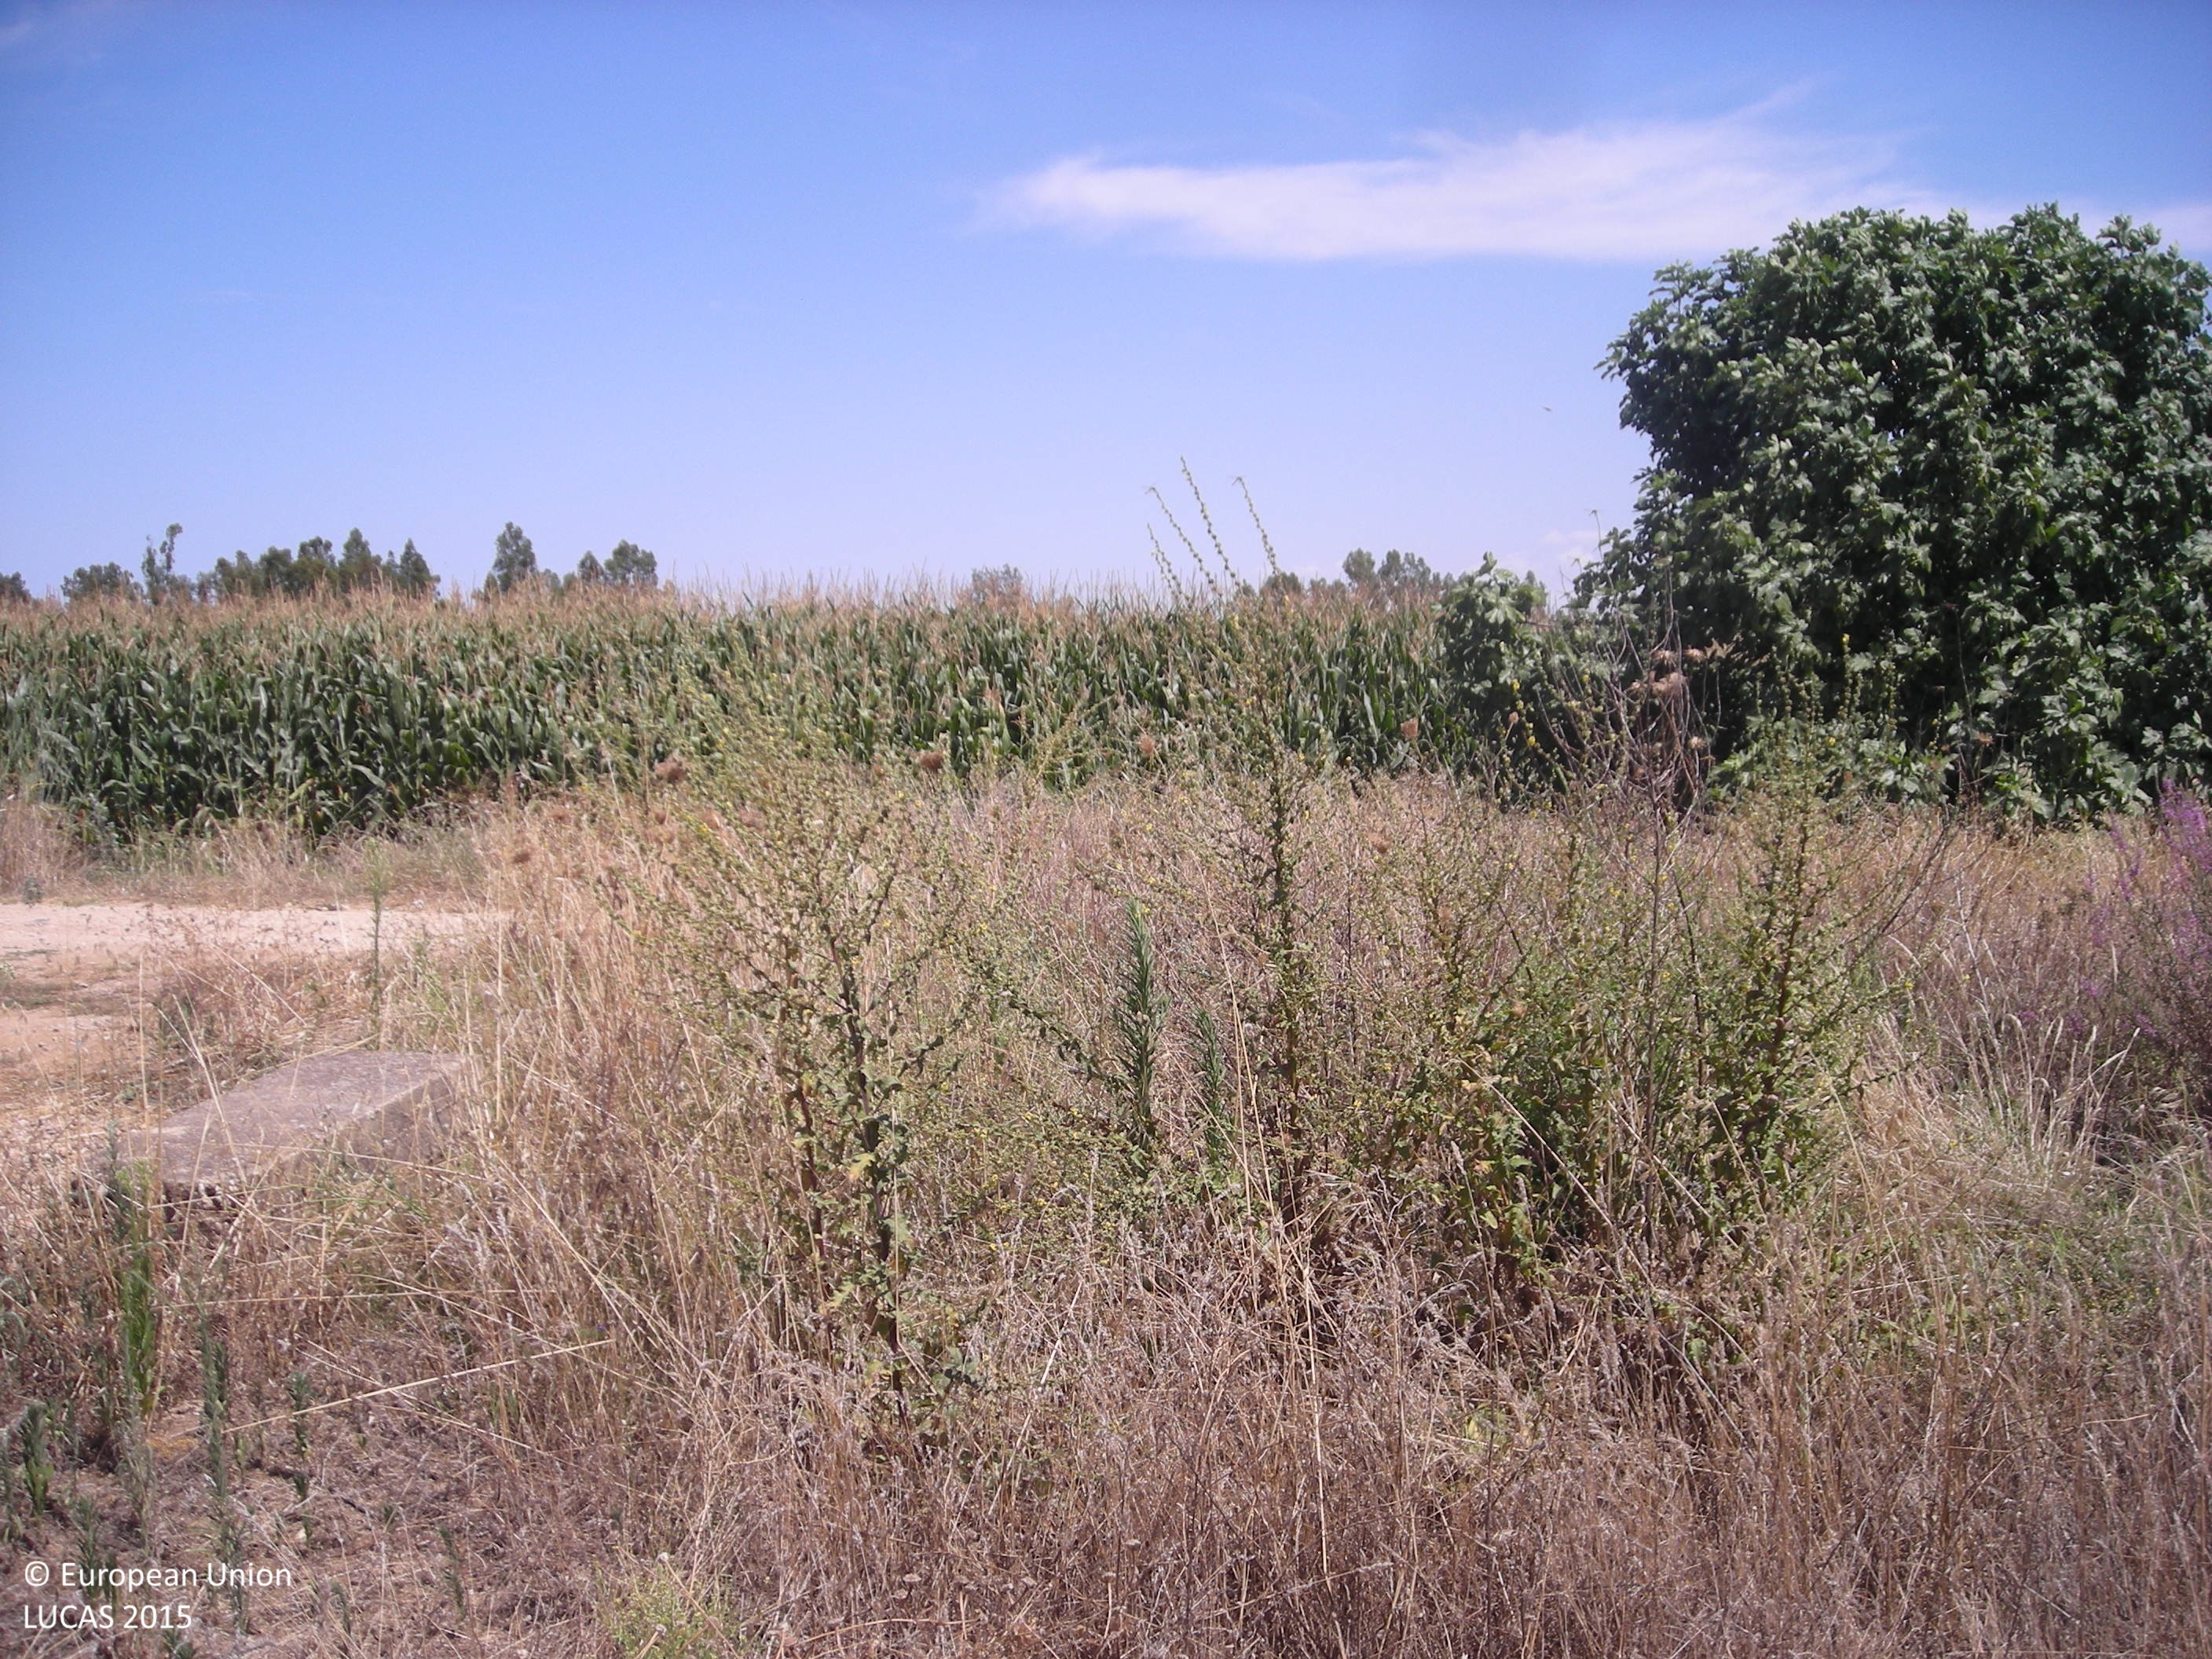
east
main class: Cropland
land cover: Rice
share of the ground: > 75 %
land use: Agriculture (excluding fallow land and kitchen gardens)
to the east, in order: Rice; Grass margins; Ditches and canals; Grass margins; Maize; Ditches and canals; Grass margins; Tracks; Grassland without tree/shrub cover; Ditches and canals; Grassland without tree/shrub cover; Rice
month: July
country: ES
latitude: 39.0114
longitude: -5.9308
